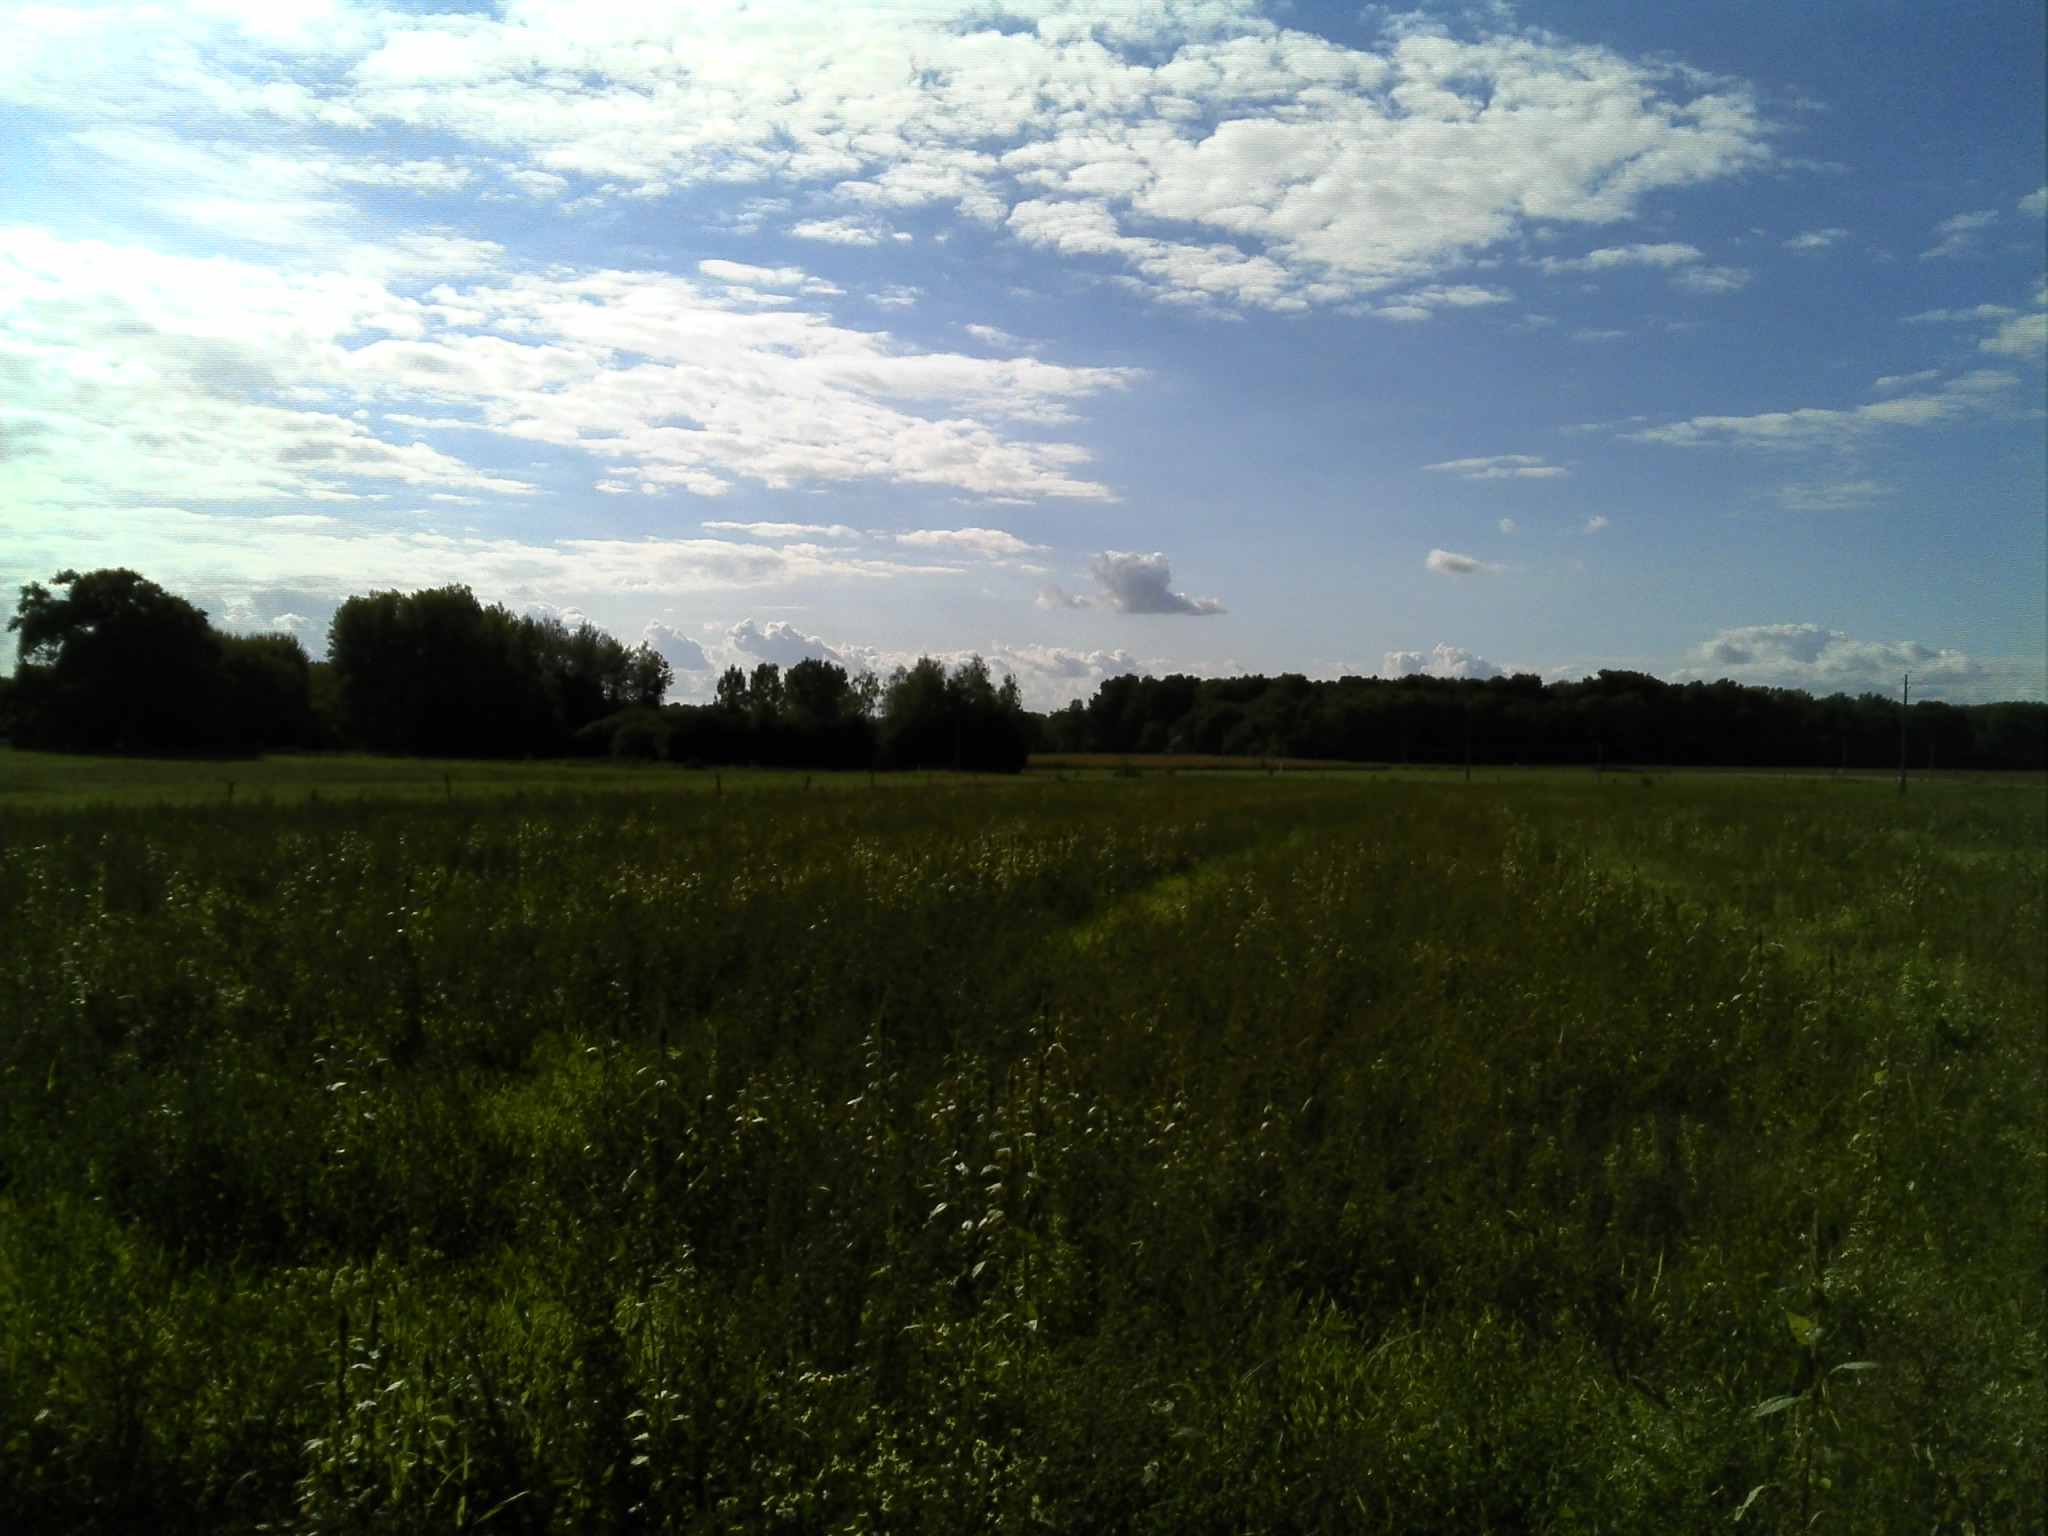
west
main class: Grassland
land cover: Spontaneously vegetated surfaces
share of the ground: > 75 %
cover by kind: herbaceous plants 100 %
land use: Agriculture (excluding fallow land and kitchen gardens)
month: September
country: FR
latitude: 47.7209
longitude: 0.2841
